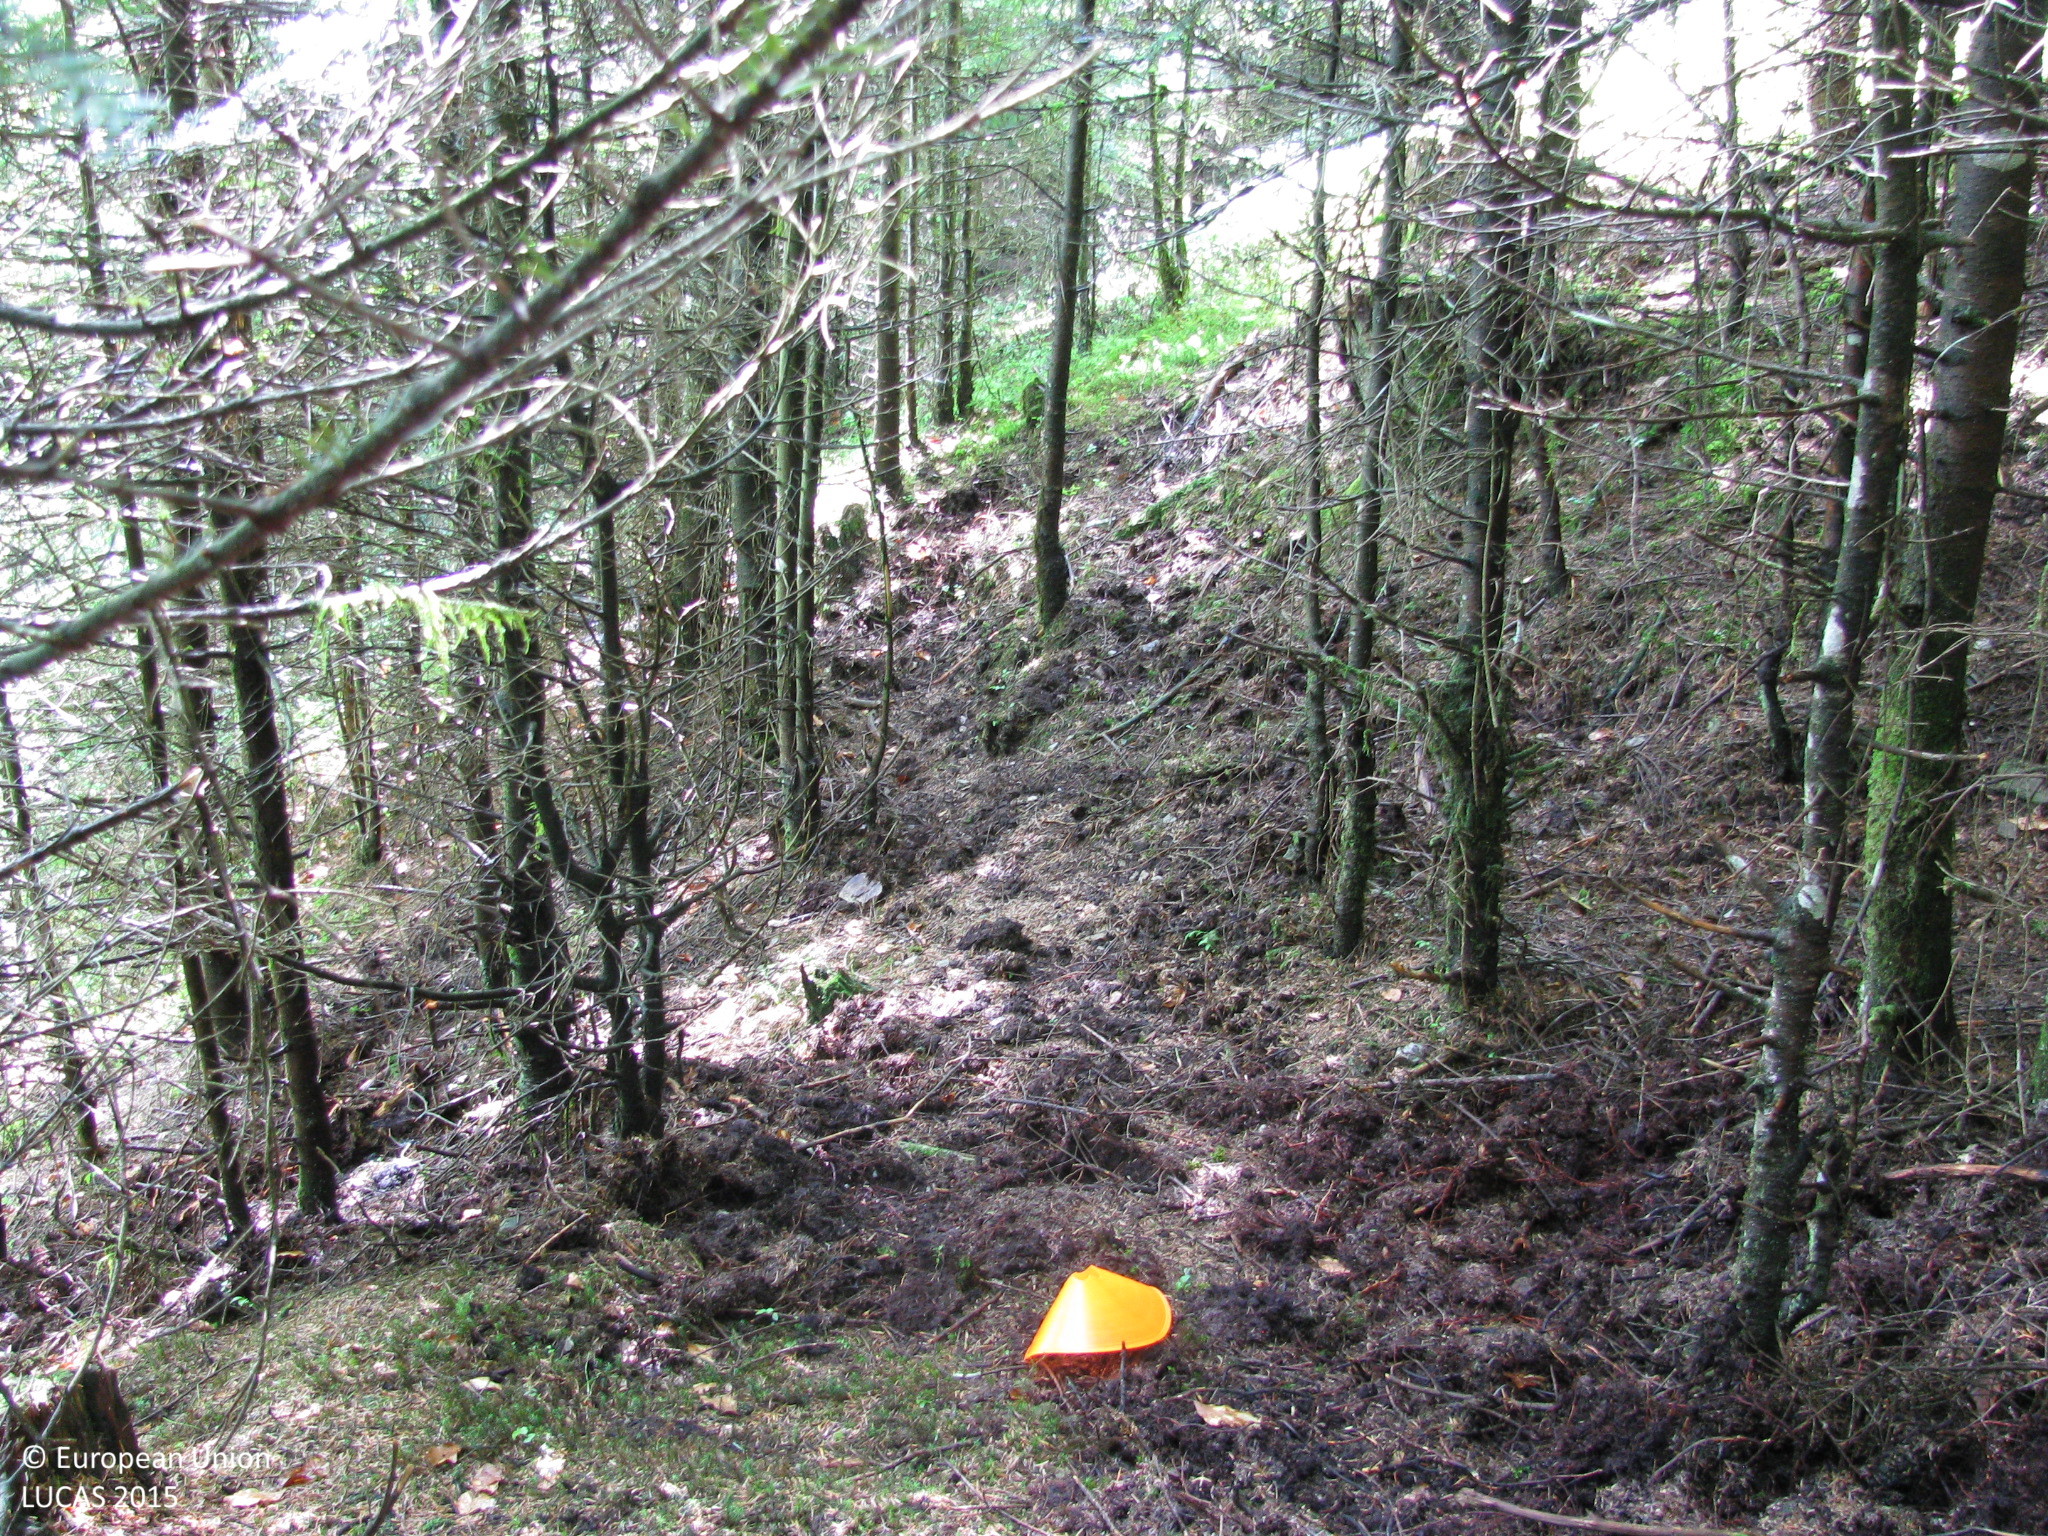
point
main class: Woodland
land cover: Other coniferous woodland
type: alpine coniferous forest
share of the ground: > 75 %
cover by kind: coniferous forest trees 90 %, broadleaved forest trees 5 %, herbaceous plants 5 %
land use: Forestry
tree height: > 5 m
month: May
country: AT
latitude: 47.5928
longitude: 14.4543
